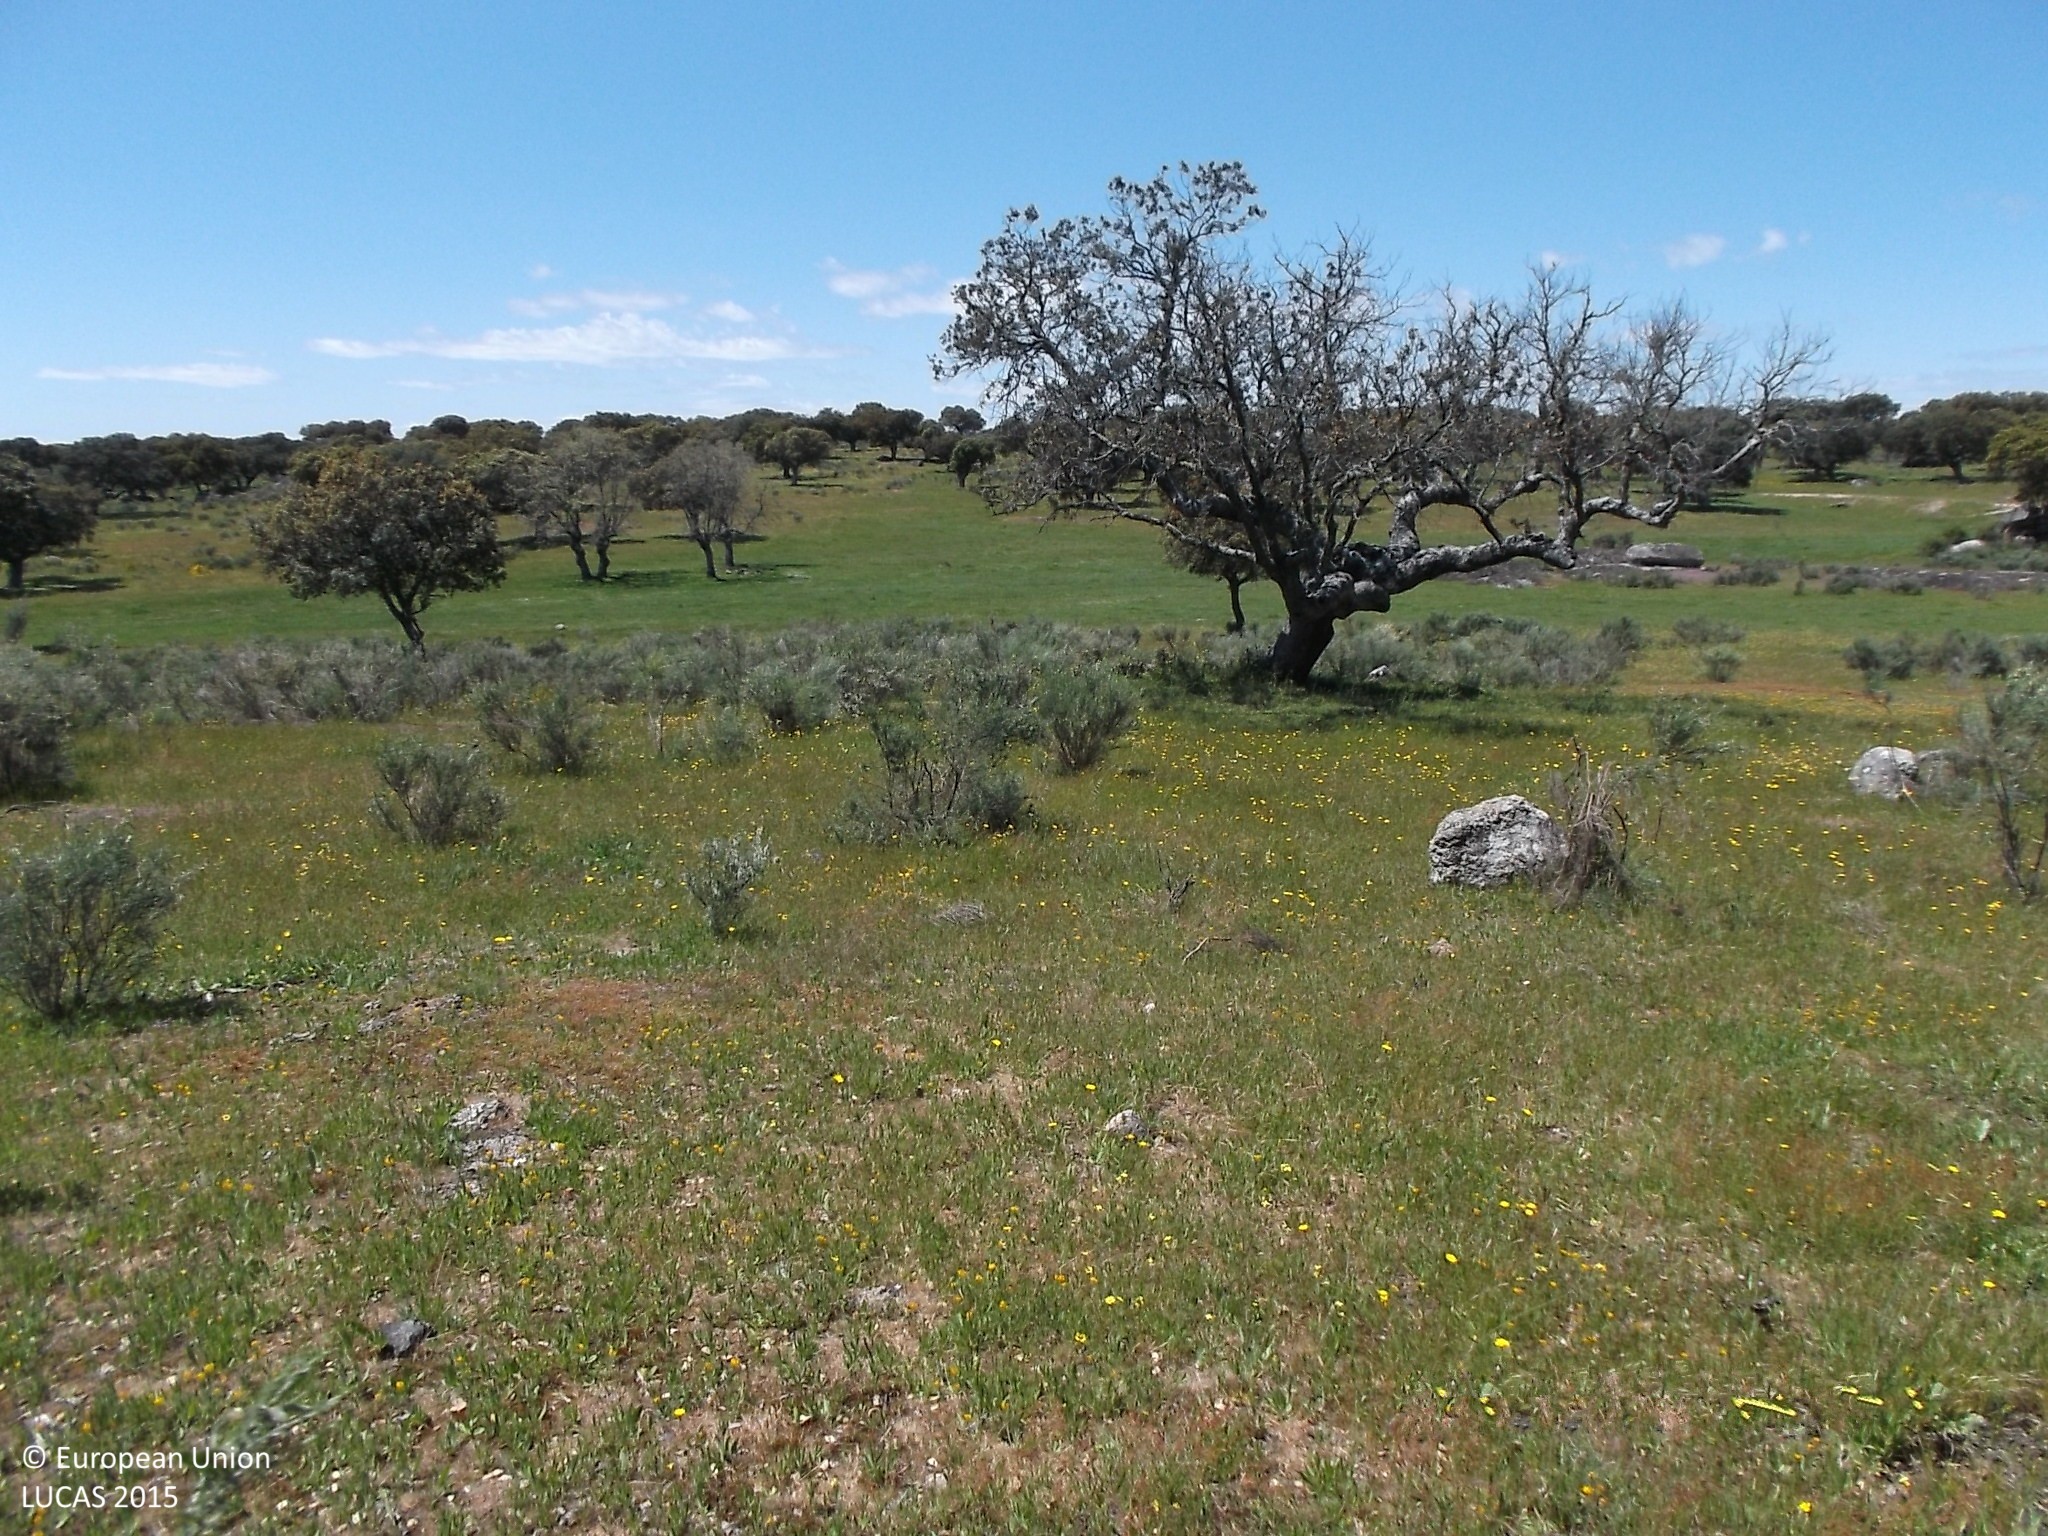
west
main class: Woodland
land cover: Broadleaved woodland
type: broadleaved evergreen forest
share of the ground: 10 - 25 %
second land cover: Grassland without tree/shrub cover
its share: > 75 %
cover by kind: herbaceous plants 70 %, broadleaved forest trees 20 %, shrubs 10 %
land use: Forestry
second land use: Agriculture (excluding fallow land and kitchen gardens)
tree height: > 5 m
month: May
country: ES
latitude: 40.9091
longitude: -6.2464
